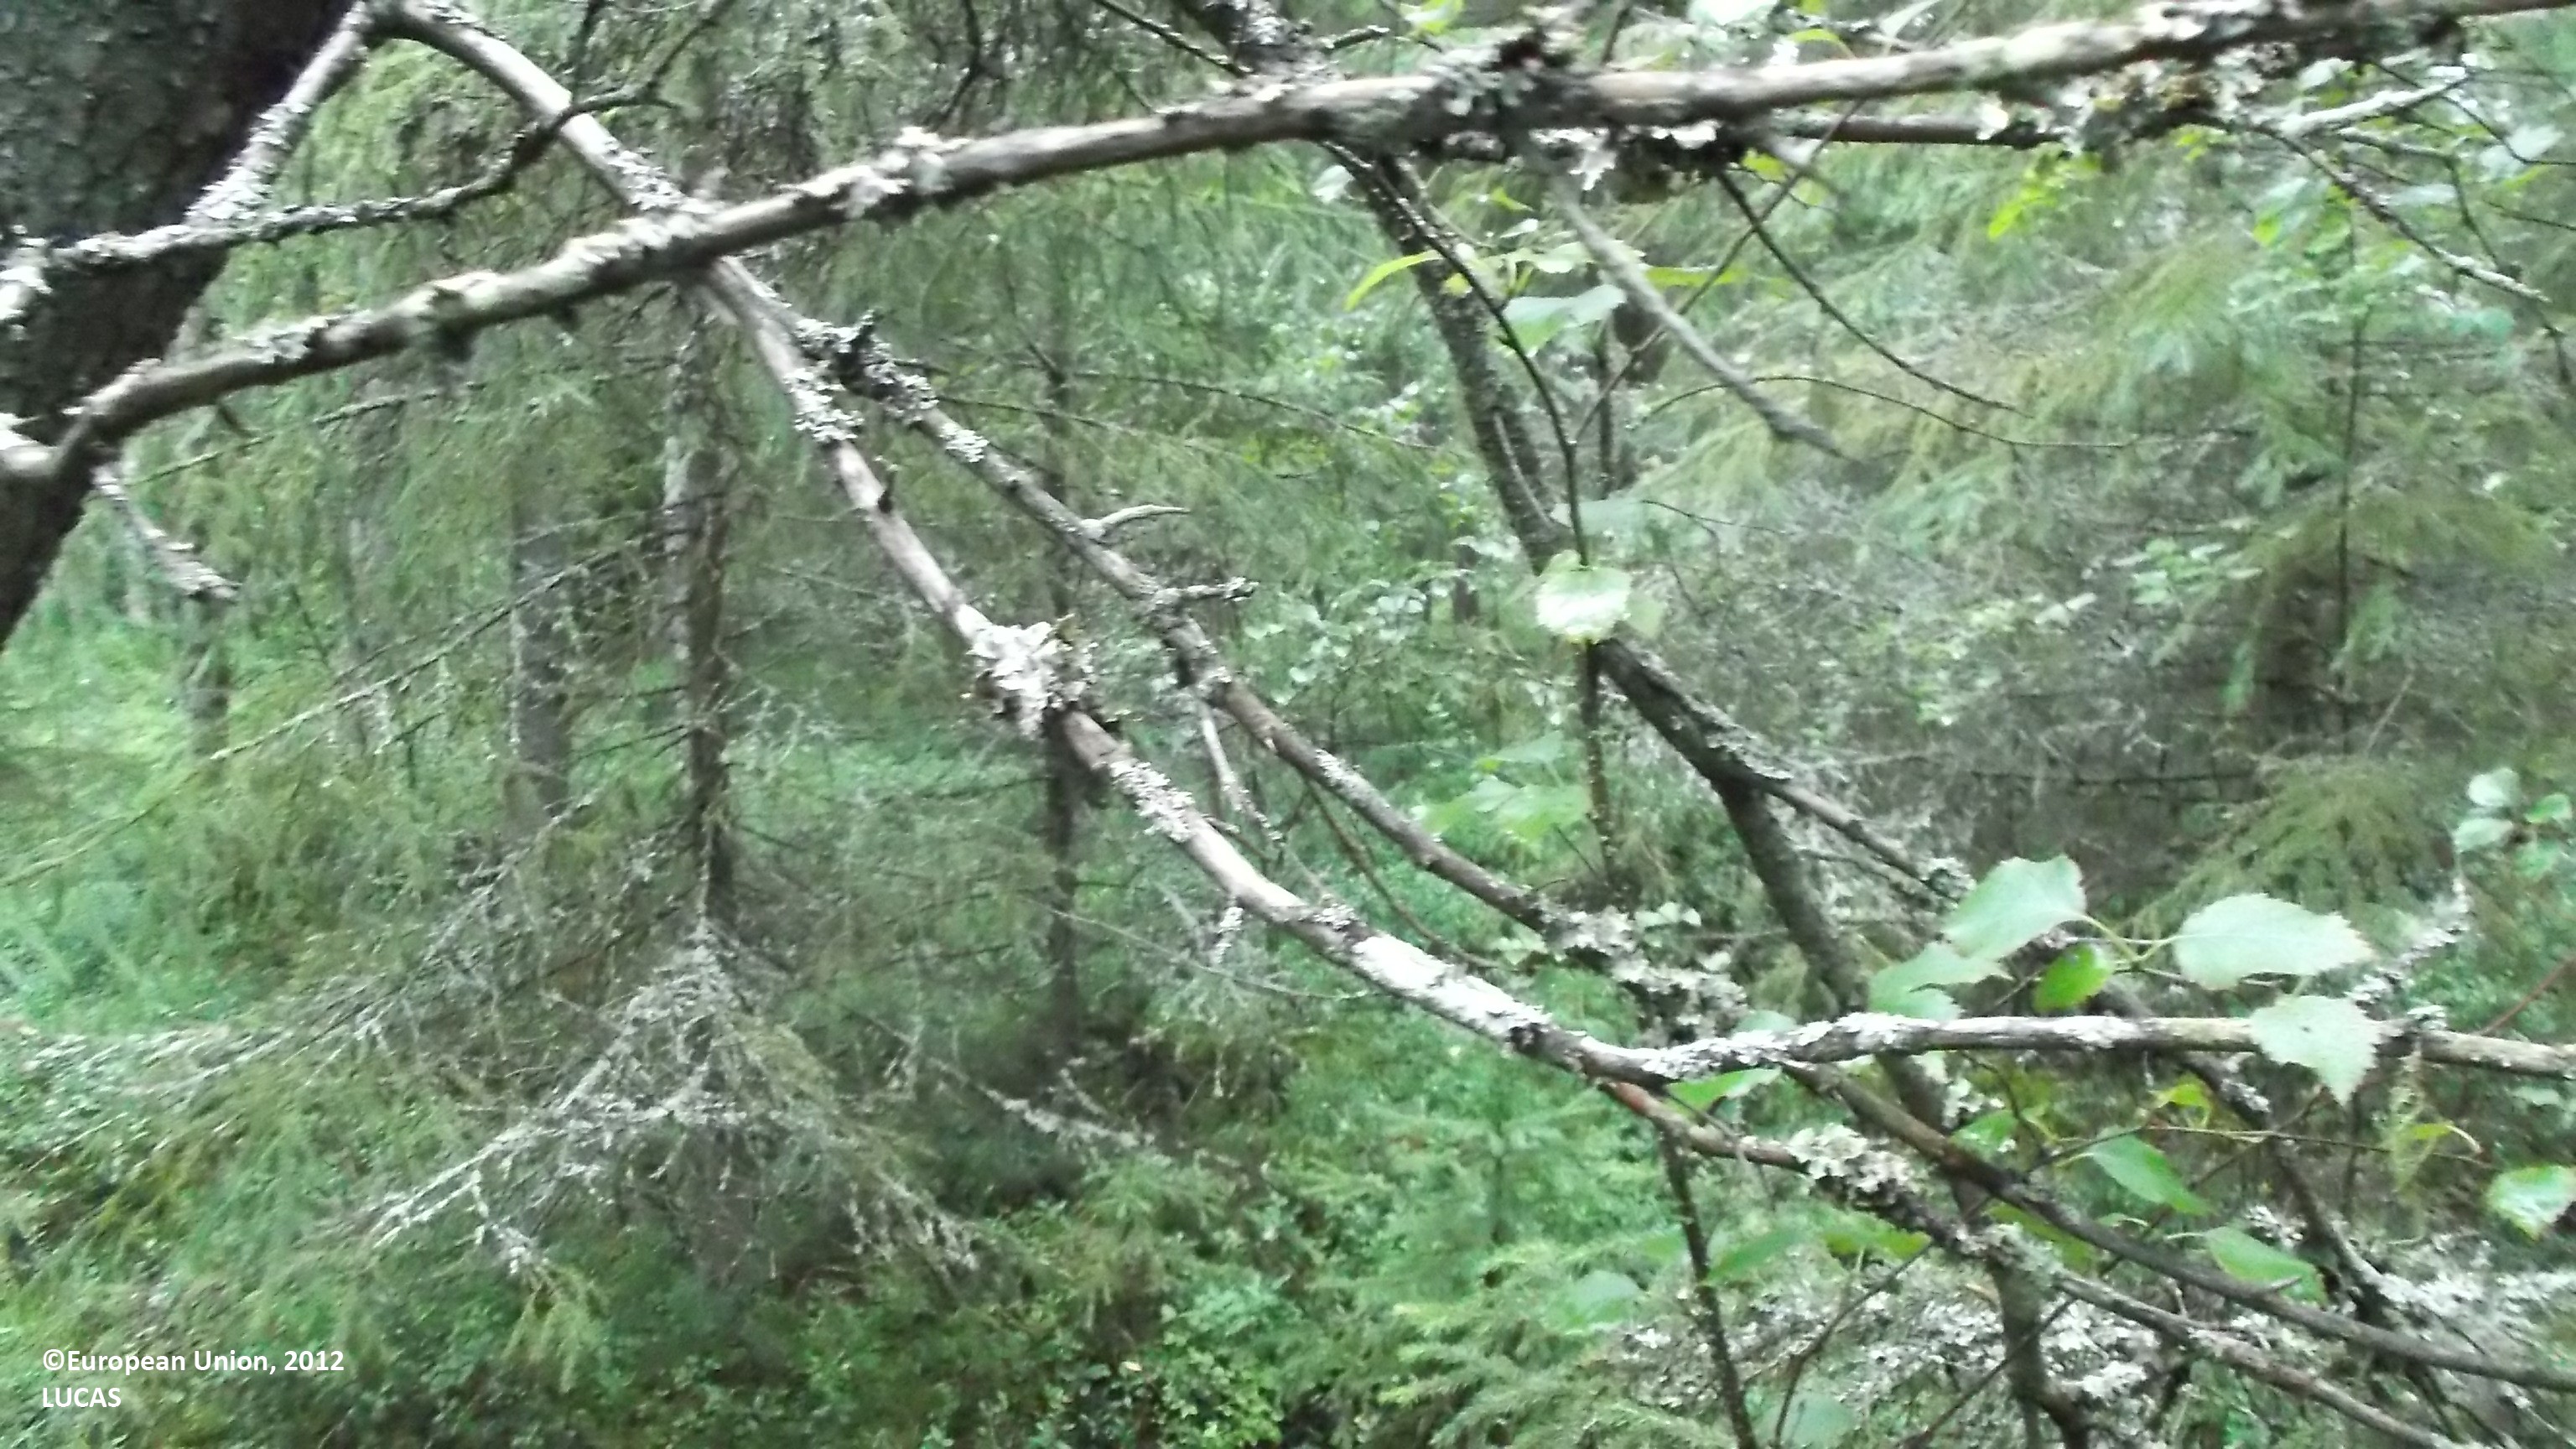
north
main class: Woodland
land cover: Spruce dominated mixed woodland
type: boreal forest
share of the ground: > 75 %
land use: Forestry
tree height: > 5 m
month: August
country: FI
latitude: 63.7657
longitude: 23.2554
